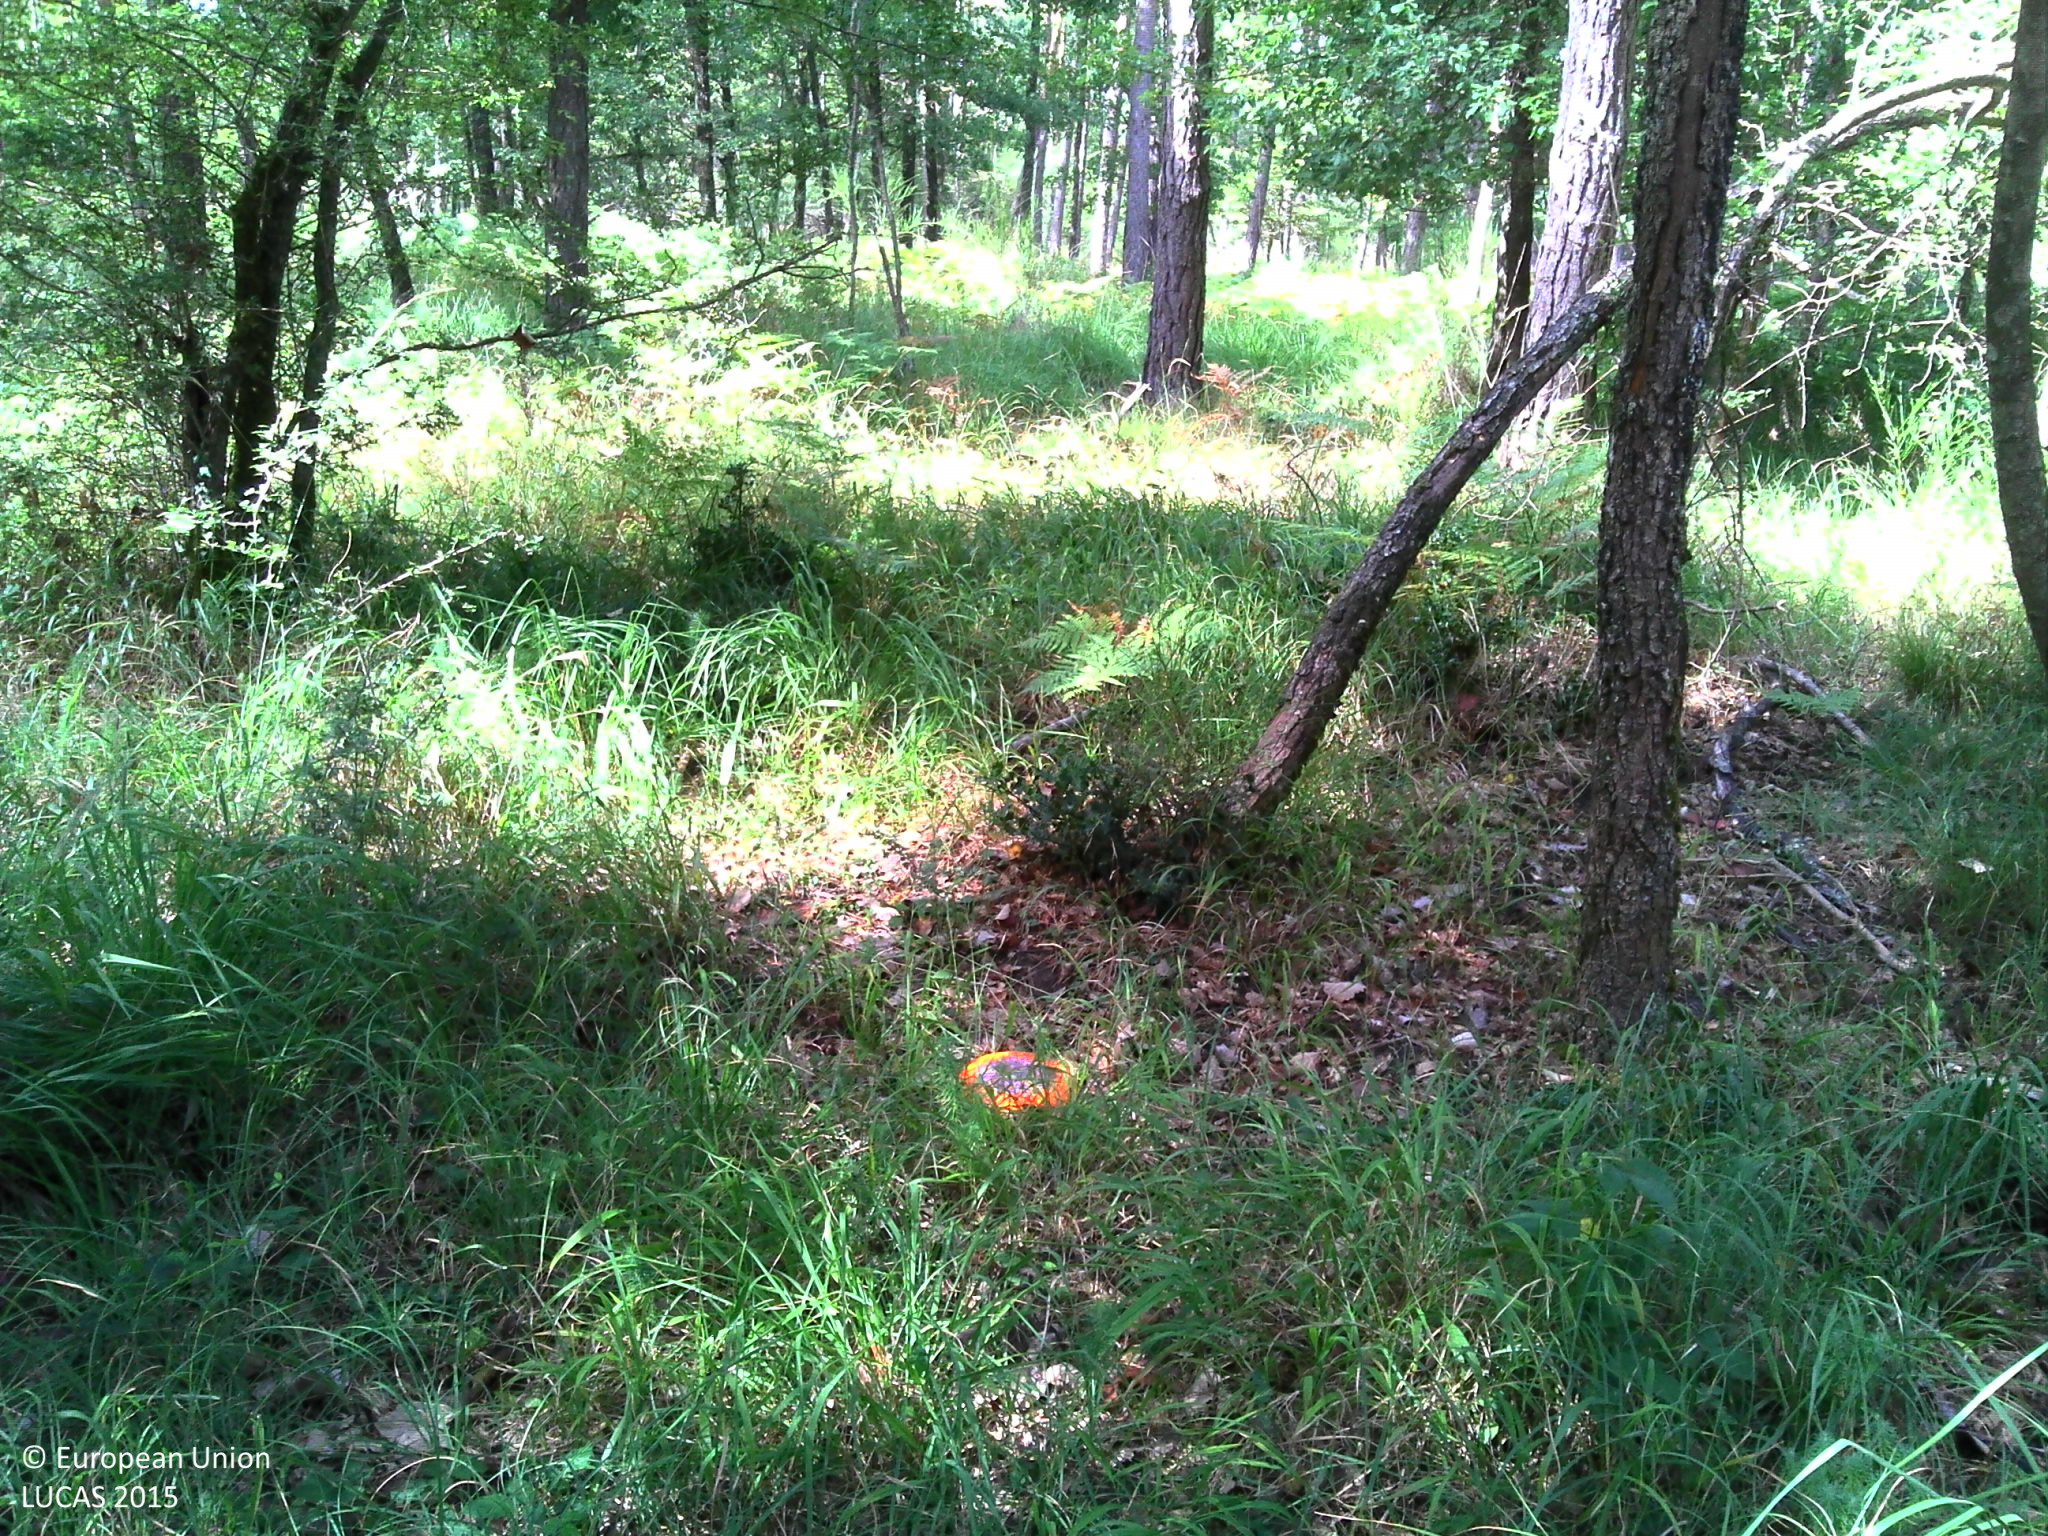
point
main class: Woodland
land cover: Pine dominated mixed woodland
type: hemiboreal forest and nemoral coniferous forest and mixed broadleaved-coniferous forest
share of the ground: > 75 %
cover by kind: herbaceous plants 45 %, broadleaved forest trees 30 %, coniferous forest trees 25 %
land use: Forestry
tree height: > 5 m
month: August
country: FR
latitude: 48.3797
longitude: 2.7132
